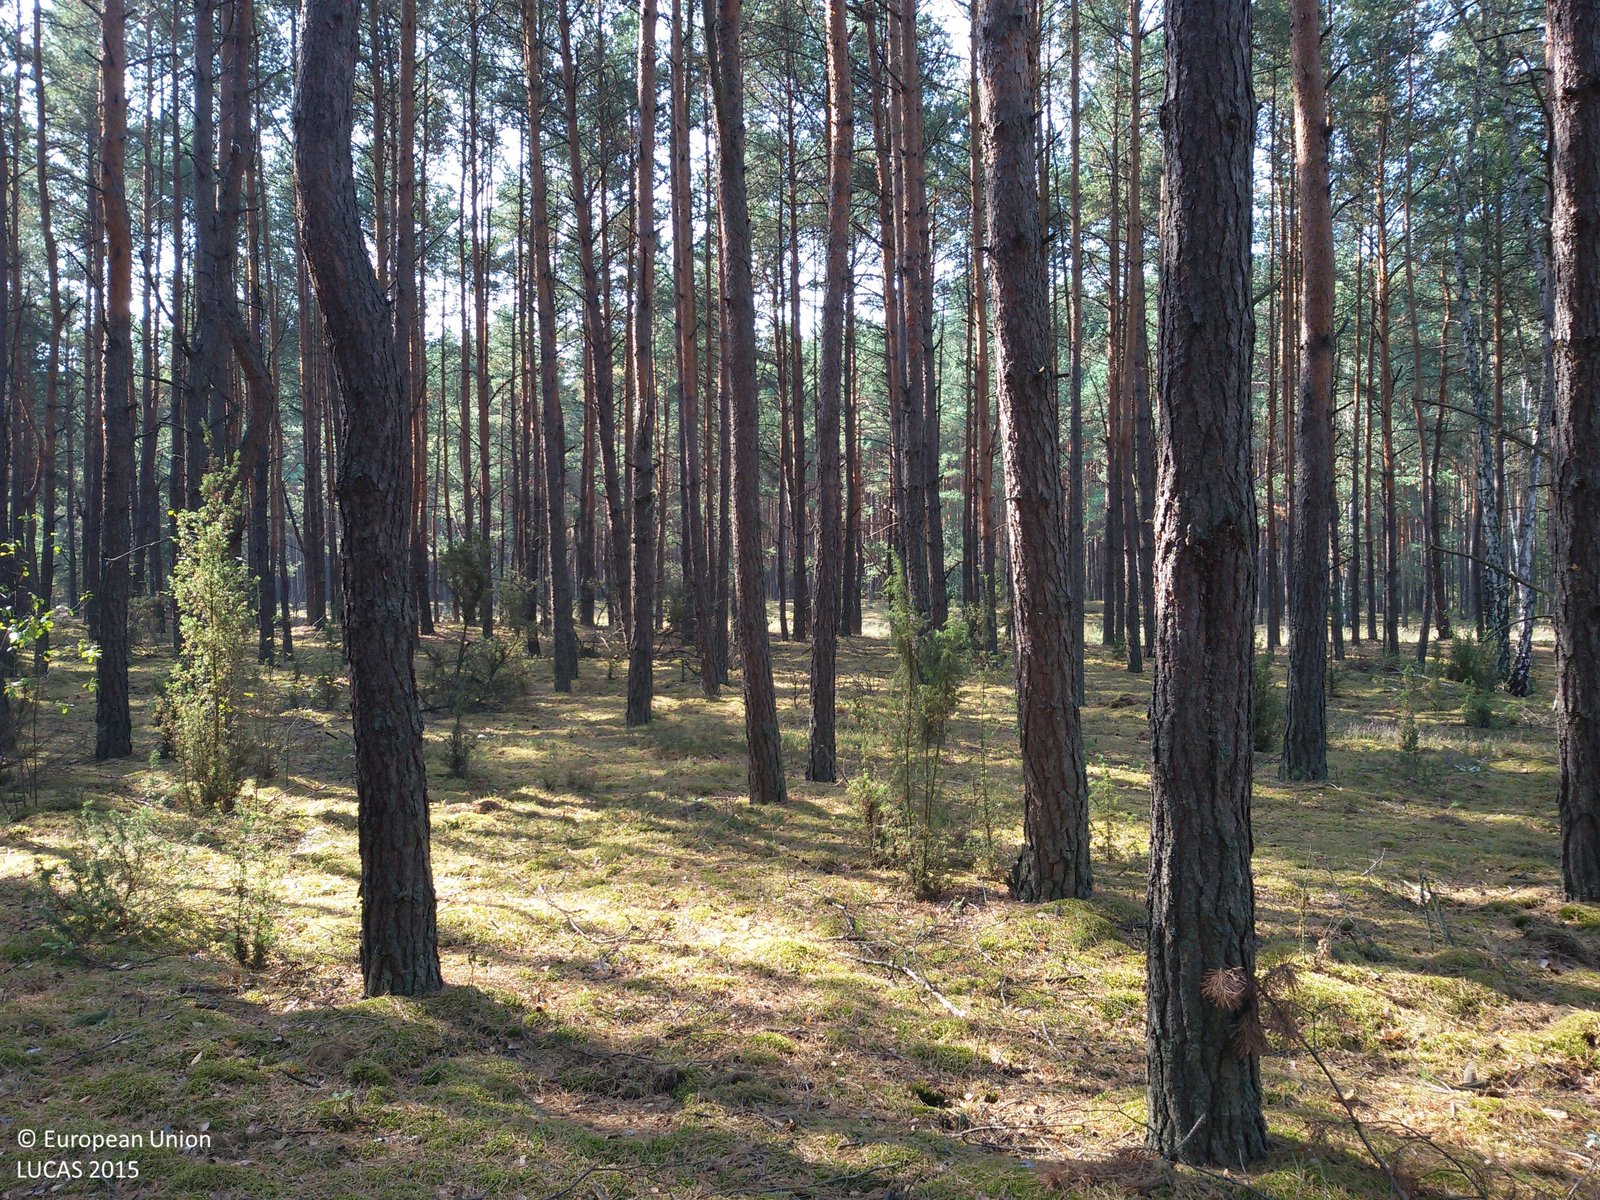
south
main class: Woodland
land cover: Pine dominated coniferous woodland
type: hemiboreal forest and nemoral coniferous forest and mixed broadleaved-coniferous forest
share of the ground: > 75 %
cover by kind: coniferous forest trees 80 %, lichens and mosses 15 %, herbaceous plants 5 %
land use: Forestry
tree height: > 5 m
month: September
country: PL
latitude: 51.4836
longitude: 18.8786
